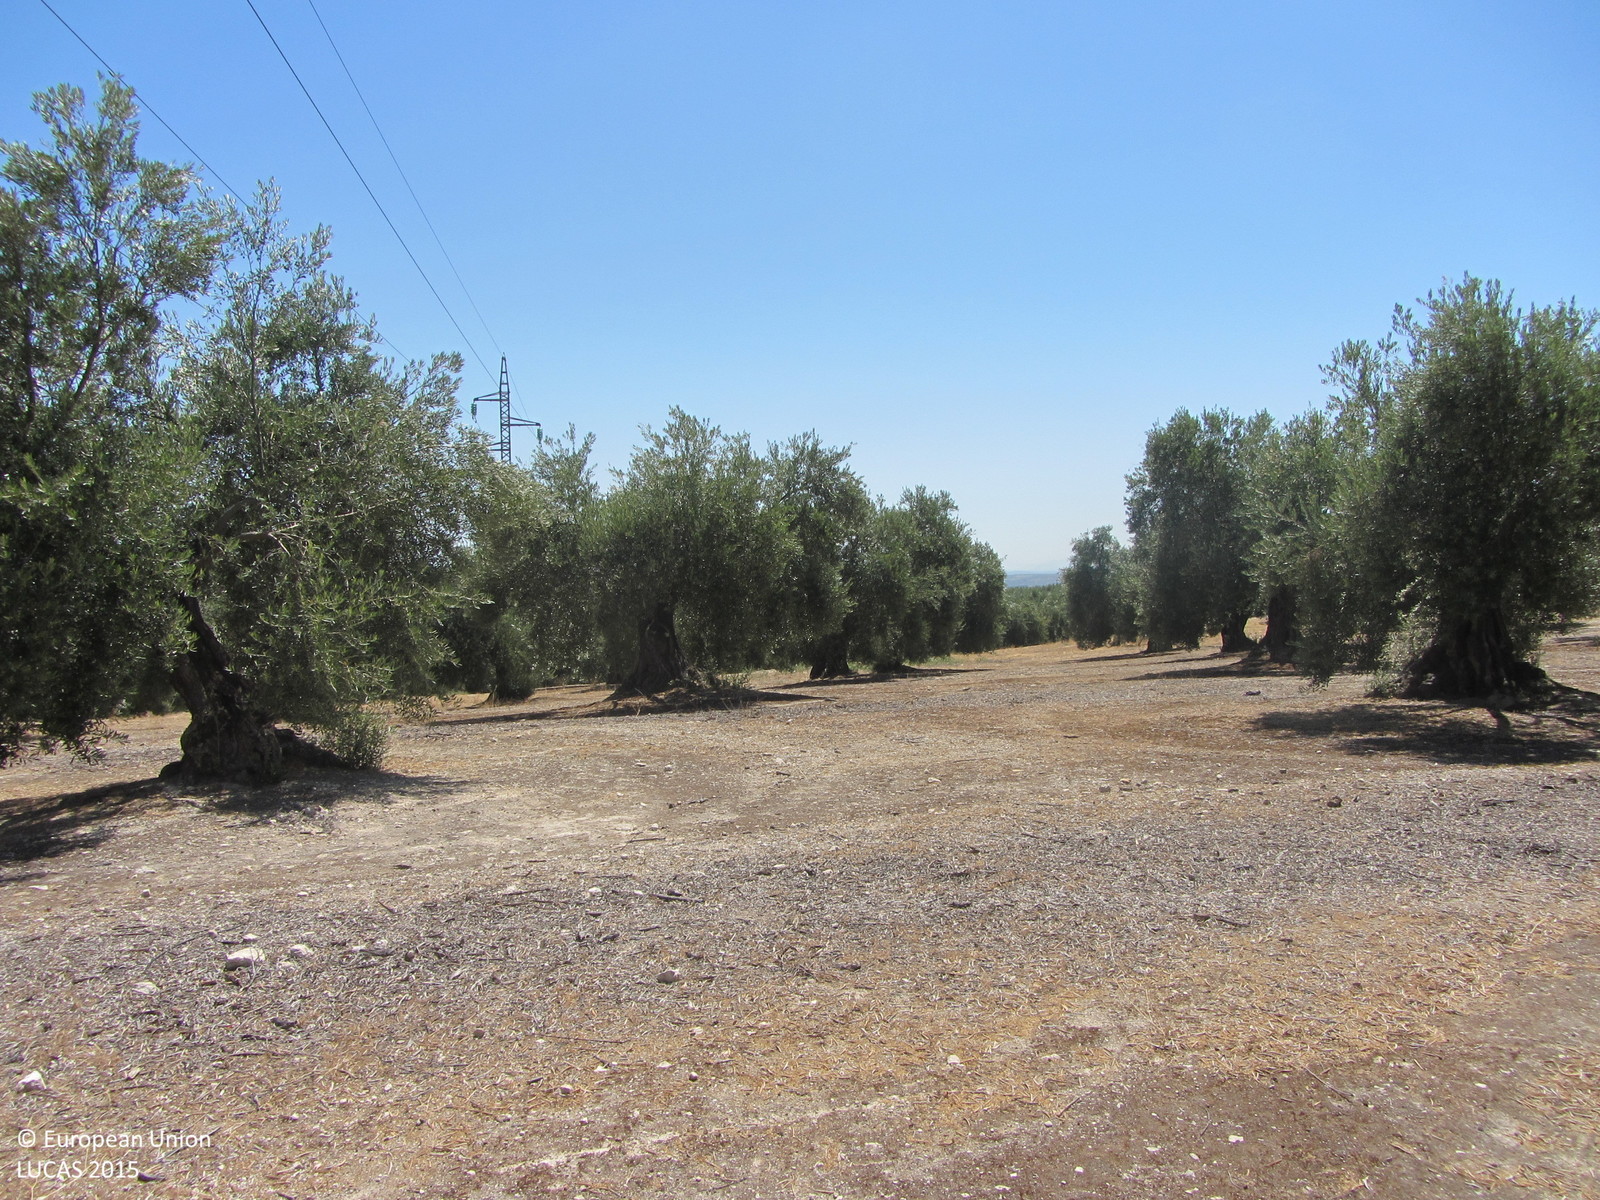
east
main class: Cropland
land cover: Olive groves
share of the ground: 25 - 50 %
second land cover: Other bare soil
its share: > 75 %
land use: Agriculture (excluding fallow land and kitchen gardens)
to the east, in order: Olive groves; Other bare soil; Grass margins; Ditches and canals; Tracks; Olive groves; Electric lines; Olive groves; Tracks; Olive groves; Other structural elements; Olive groves
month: July
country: ES
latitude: 37.9972
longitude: -3.8405
